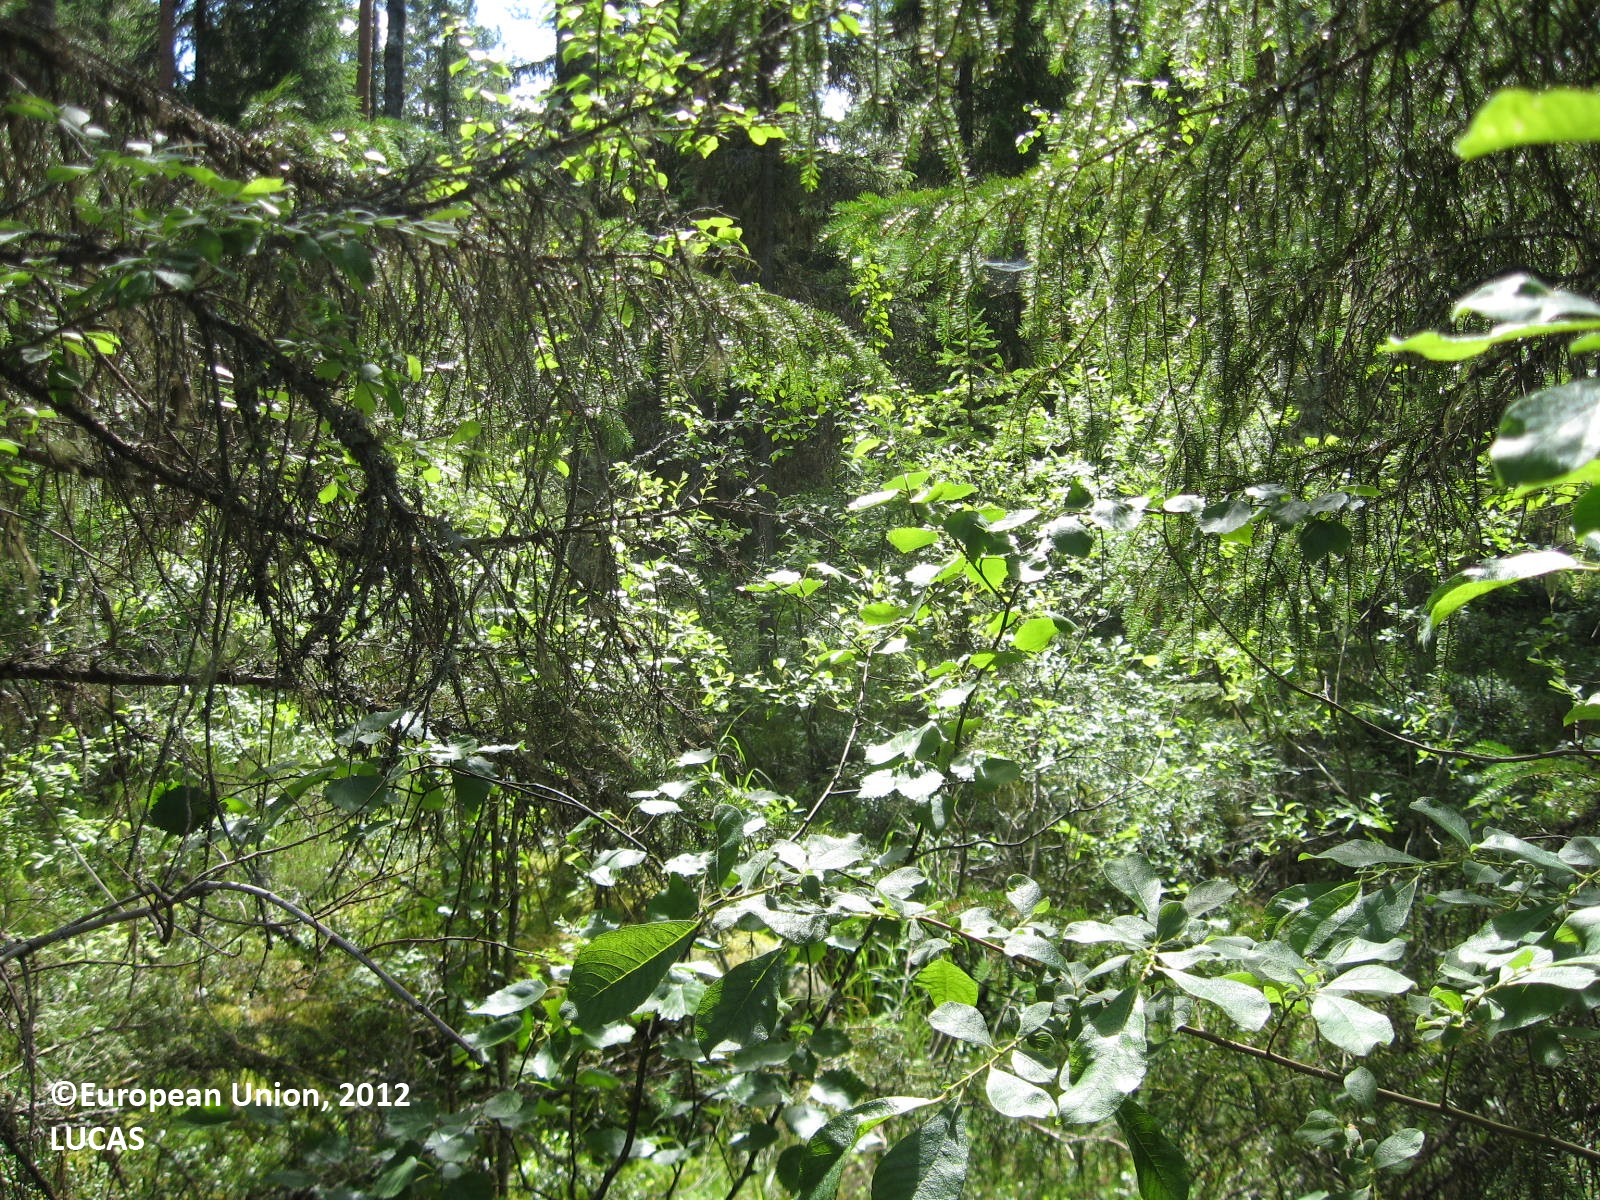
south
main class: Woodland
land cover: Spruce dominated mixed woodland
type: boreal forest
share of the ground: > 75 %
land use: Forestry
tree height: > 5 m
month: July
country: FI
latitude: 62.4593
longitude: 21.5401
